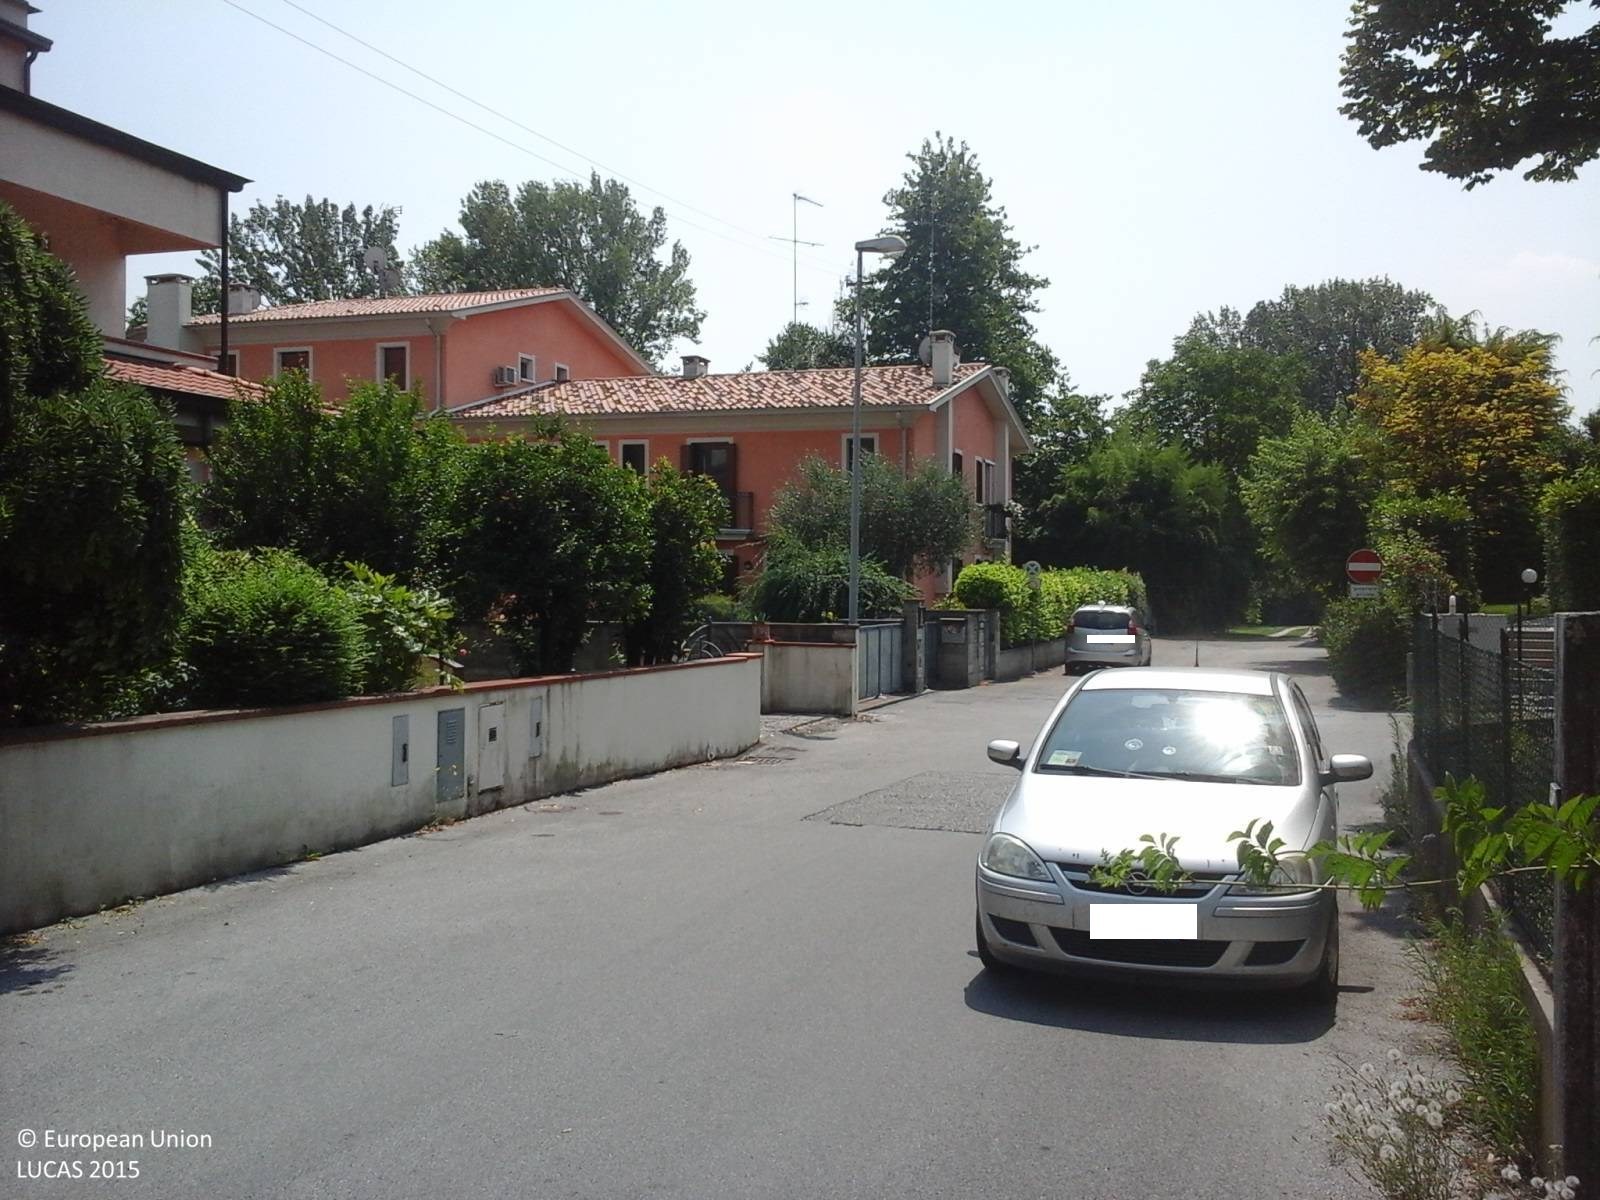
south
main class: Grassland
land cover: Grassland with sparse tree/shrub cover
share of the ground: > 75 %
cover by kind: herbaceous plants 95 %, broadleaved forest trees 5 %
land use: Residential
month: July
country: IT
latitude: 45.9581
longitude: 12.6417
